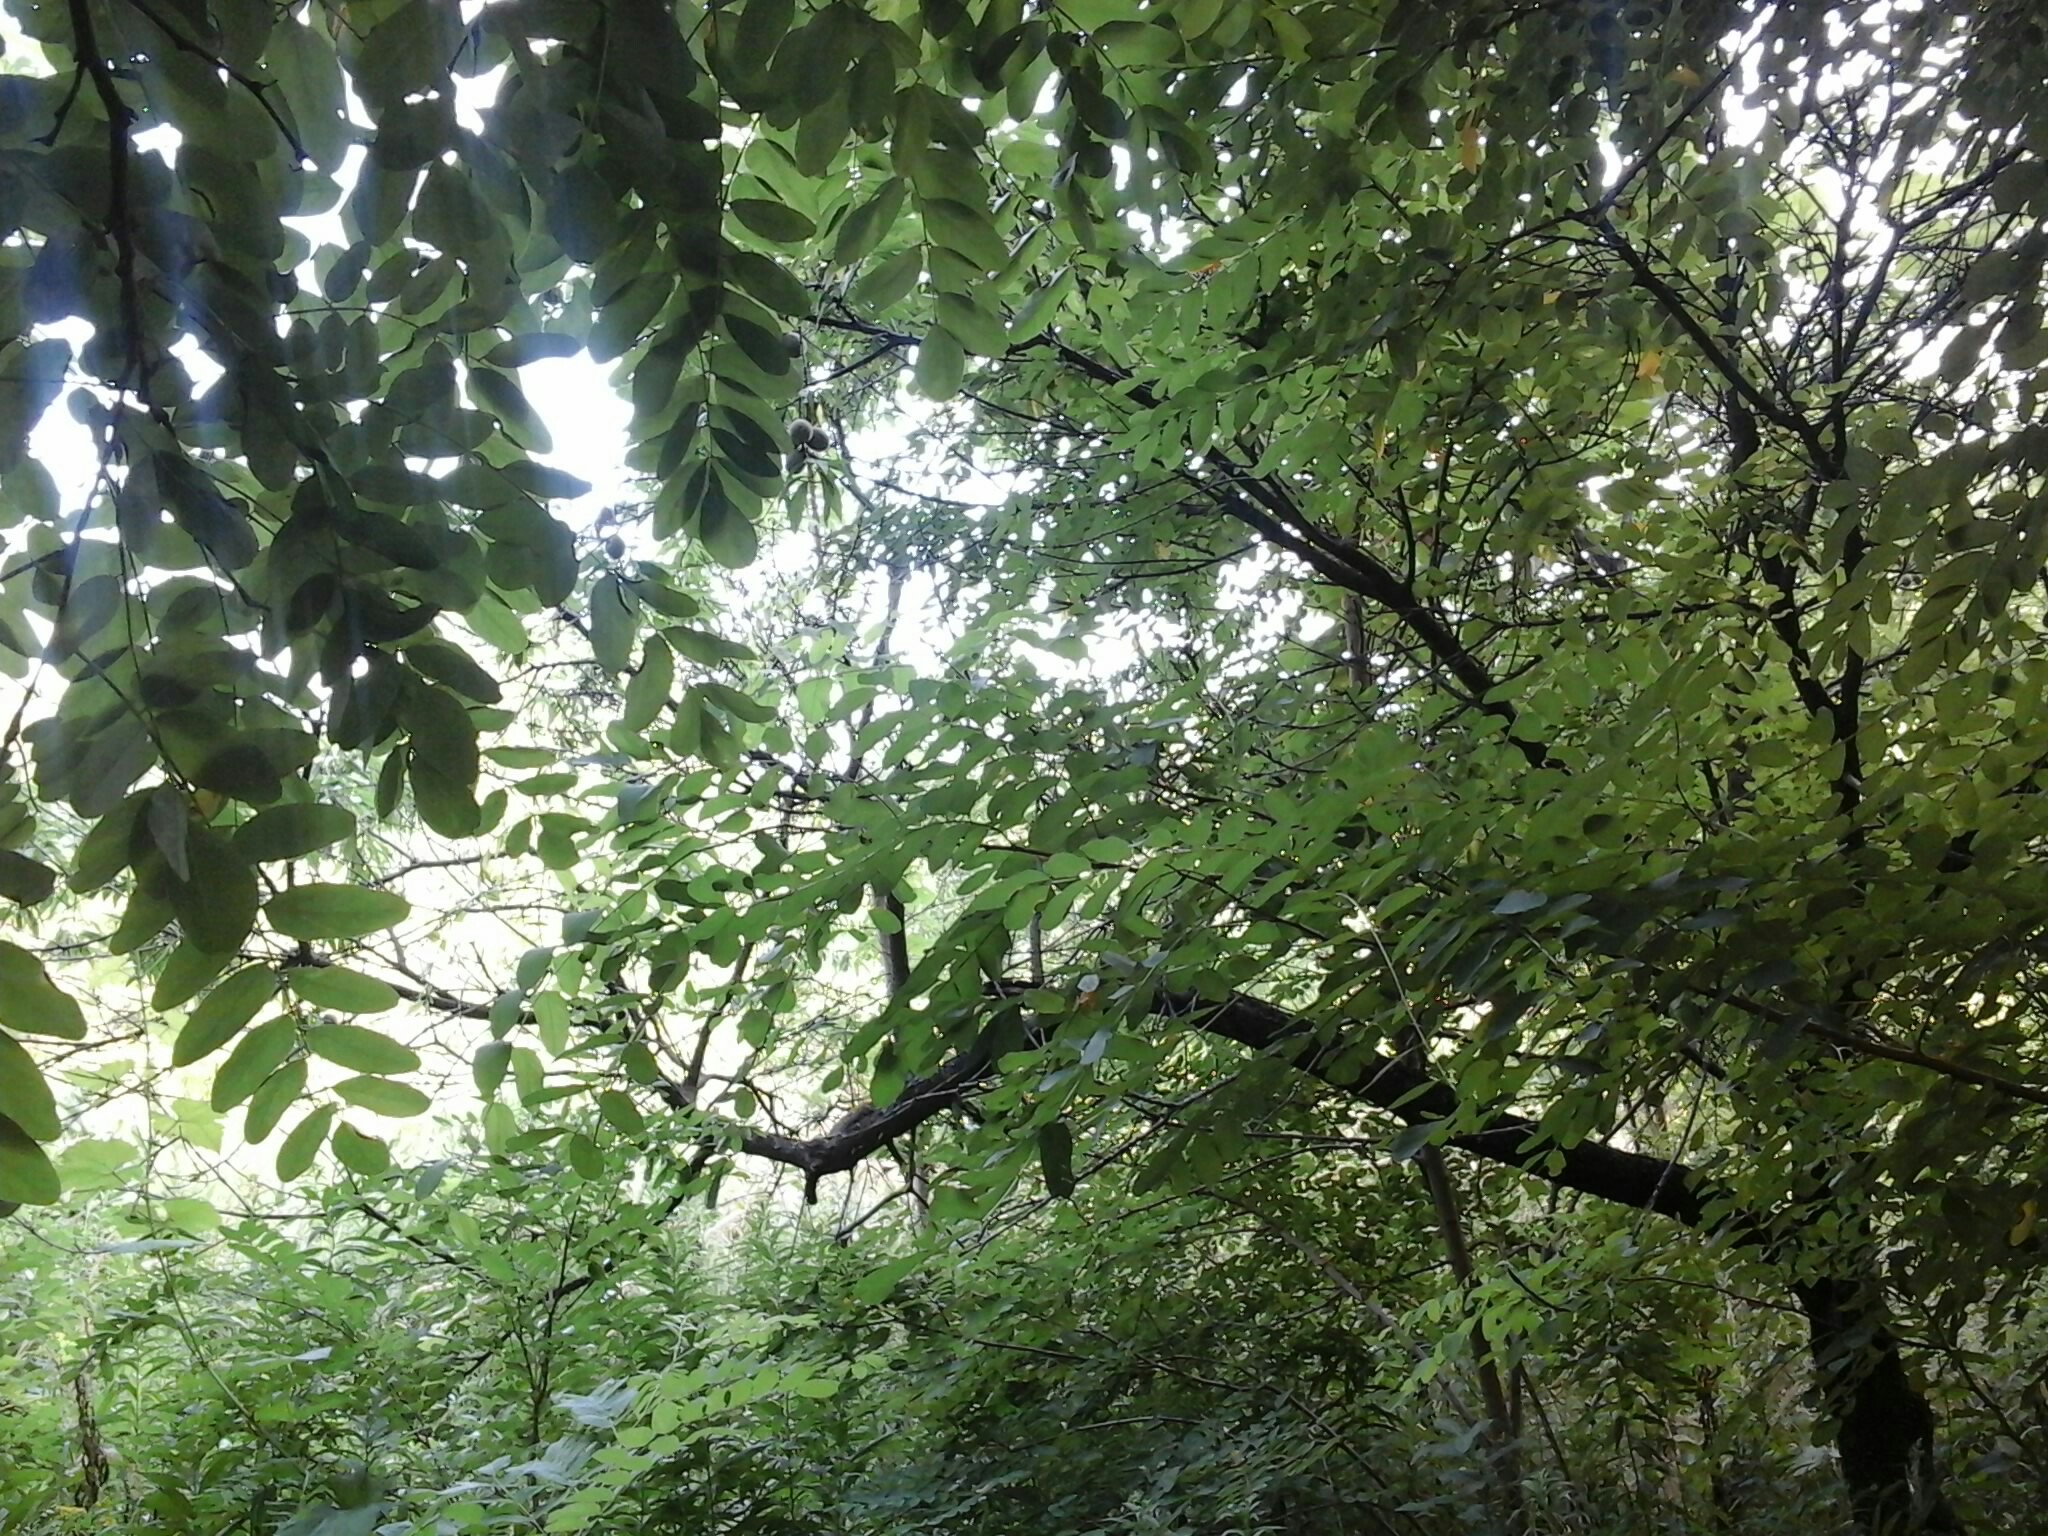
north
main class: Woodland
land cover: Broadleaved woodland
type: exotic forest
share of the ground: > 75 %
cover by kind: broadleaved forest trees 95 %, herbaceous plants 5 %
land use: Forestry
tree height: > 5 m
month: August
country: HU
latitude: 47.5230
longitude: 17.9125
